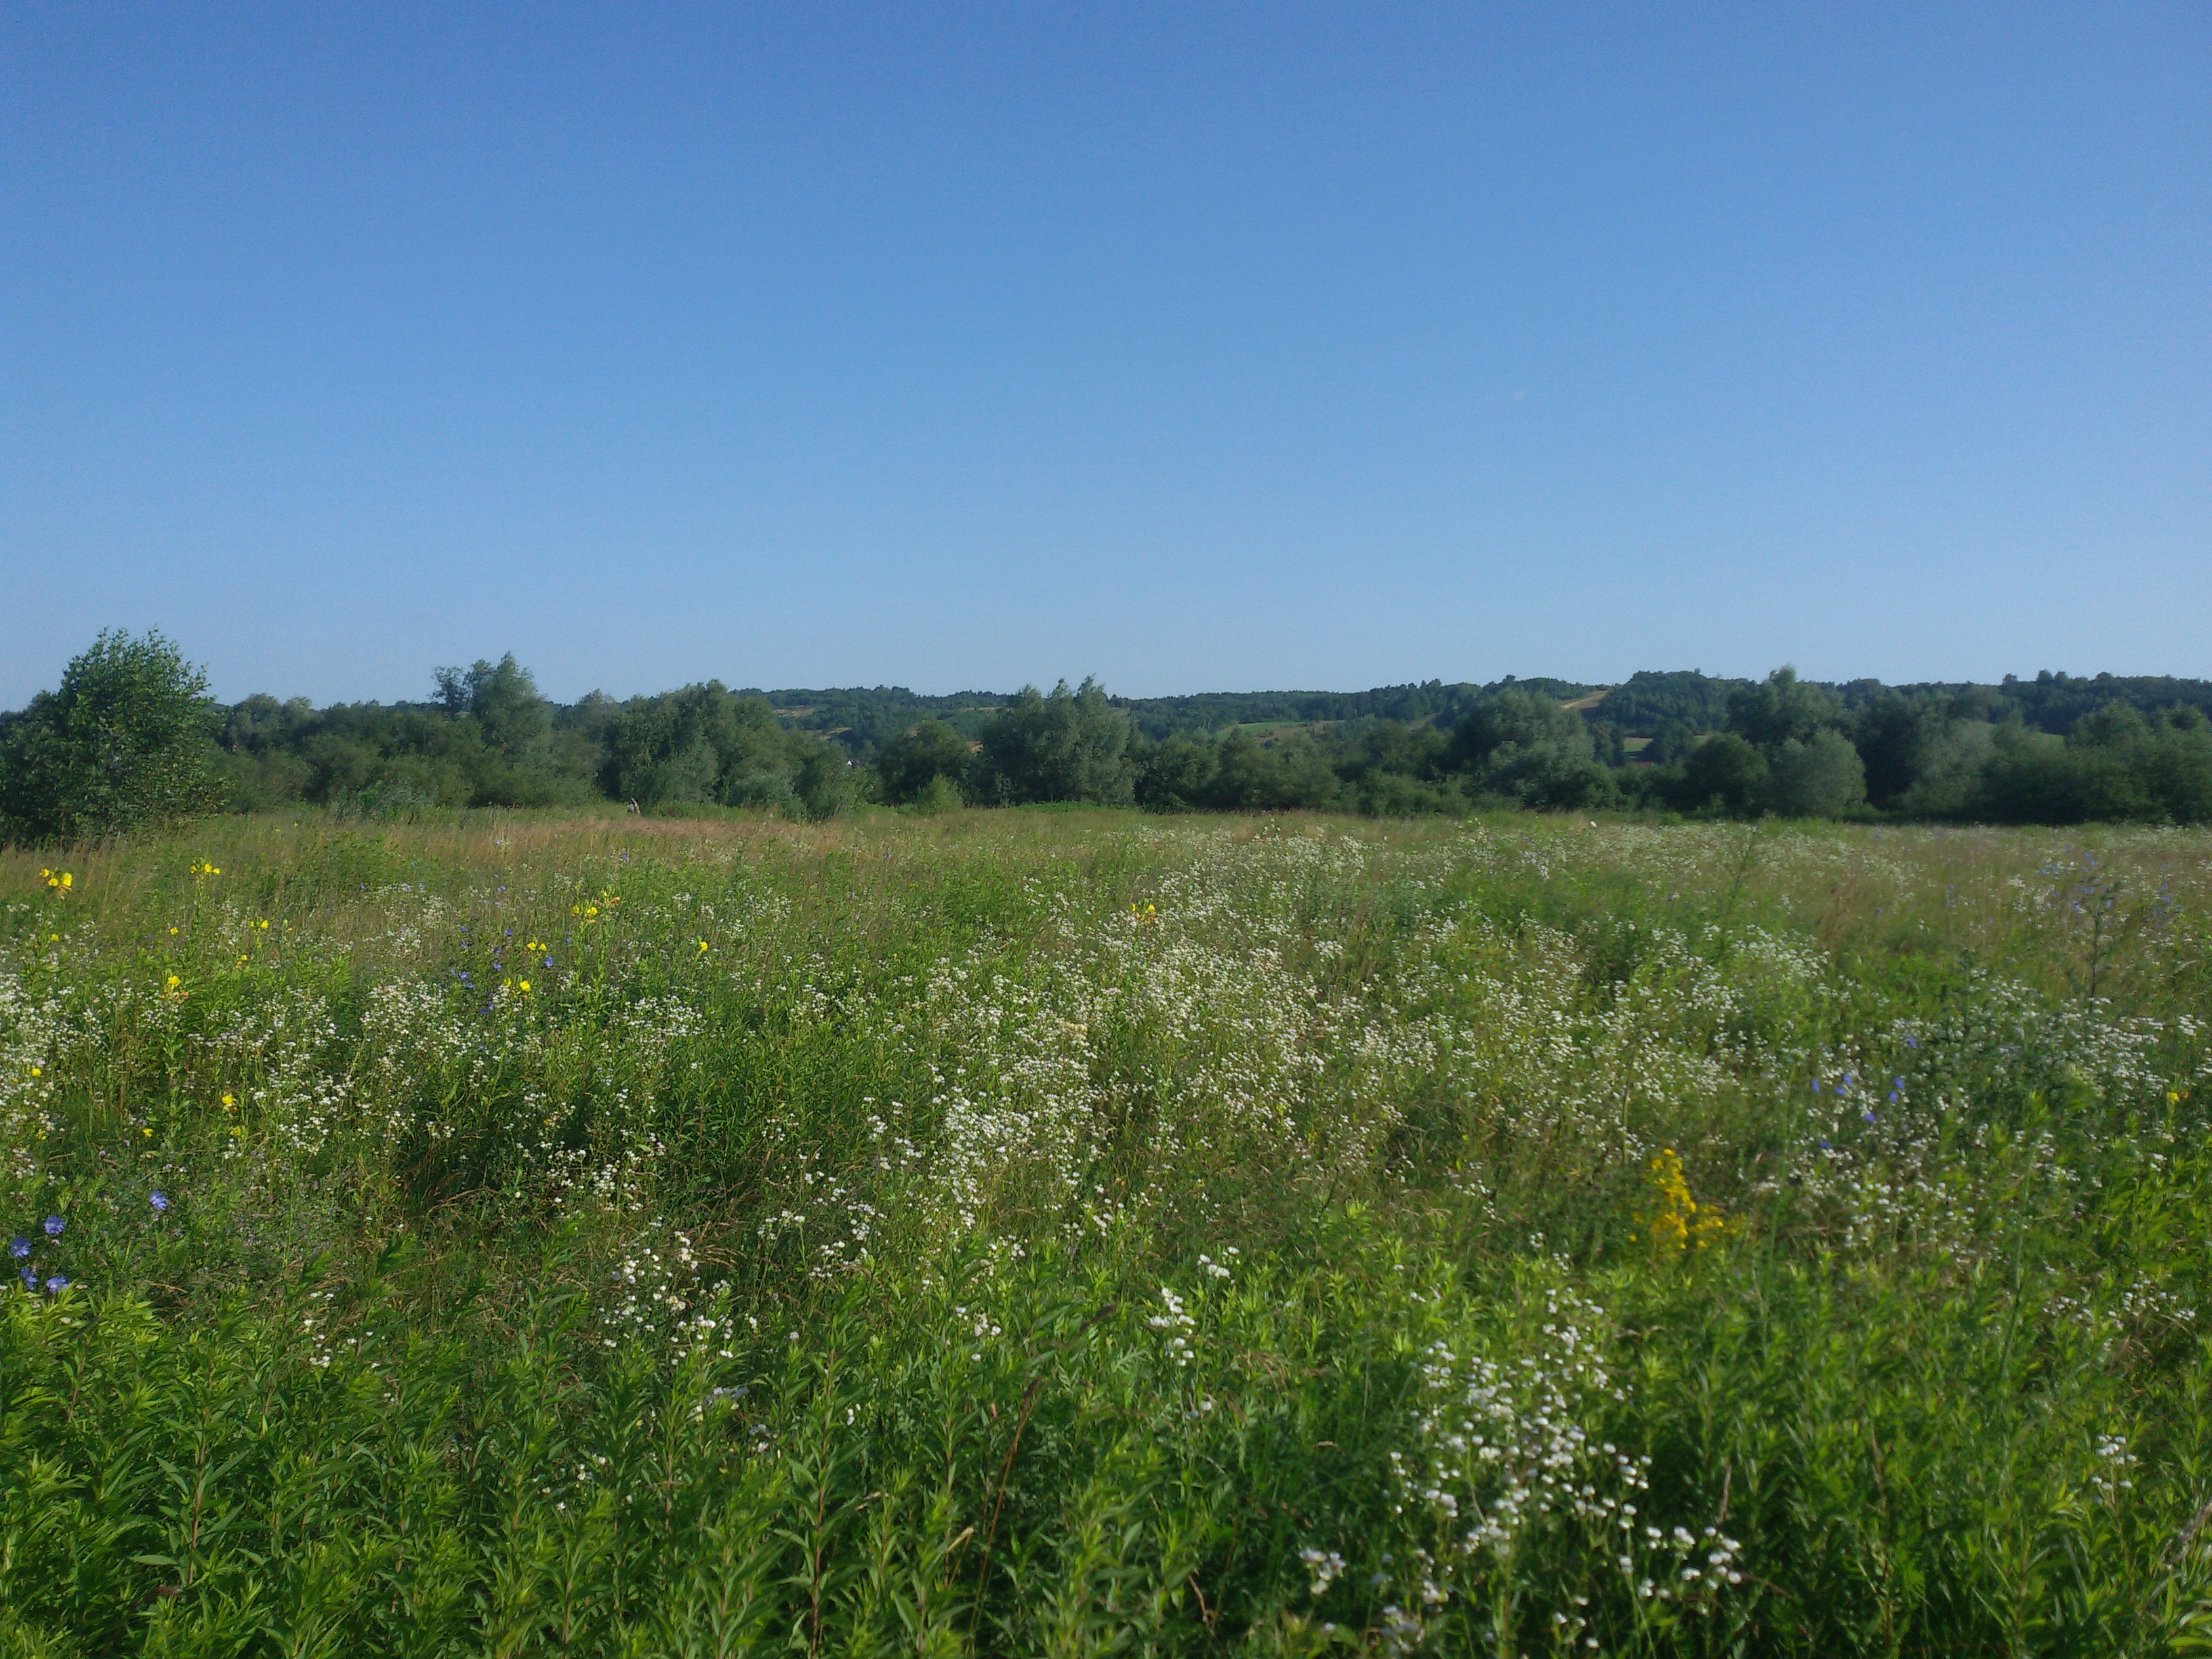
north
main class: Grassland
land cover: Spontaneously vegetated surfaces
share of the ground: > 75 %
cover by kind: herbaceous plants 100 %
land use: Semi-natural and natural areas not in use
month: July
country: PL
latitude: 49.8266
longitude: 22.2804
